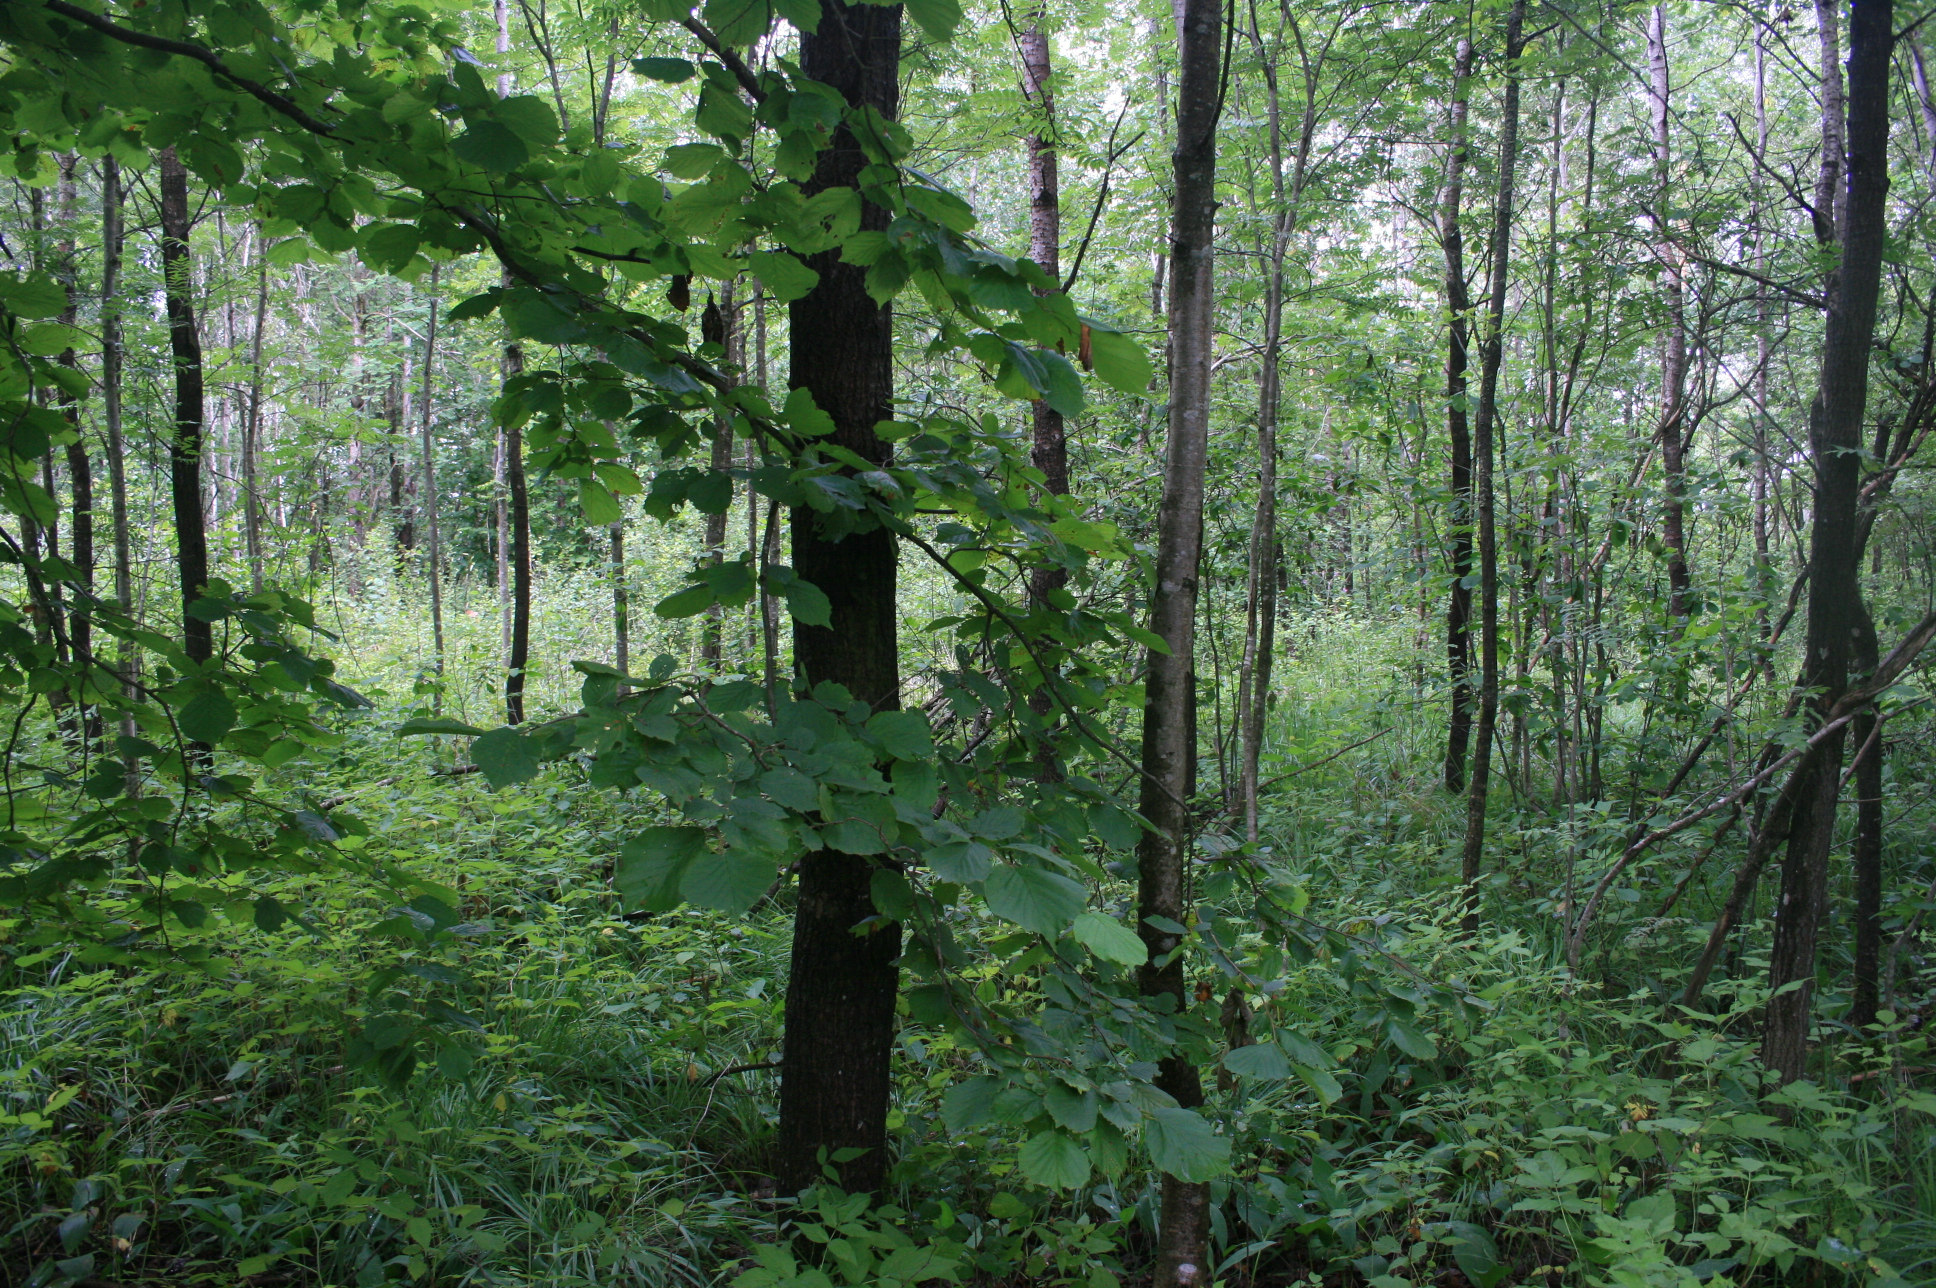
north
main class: Woodland
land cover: Broadleaved woodland
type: non-riverine alder, birch or aspen forest
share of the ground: > 75 %
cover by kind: broadleaved forest trees 90 %, herbaceous plants 10 %
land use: Forestry
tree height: > 5 m
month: July
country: LT
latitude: 55.9061
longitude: 21.2867
